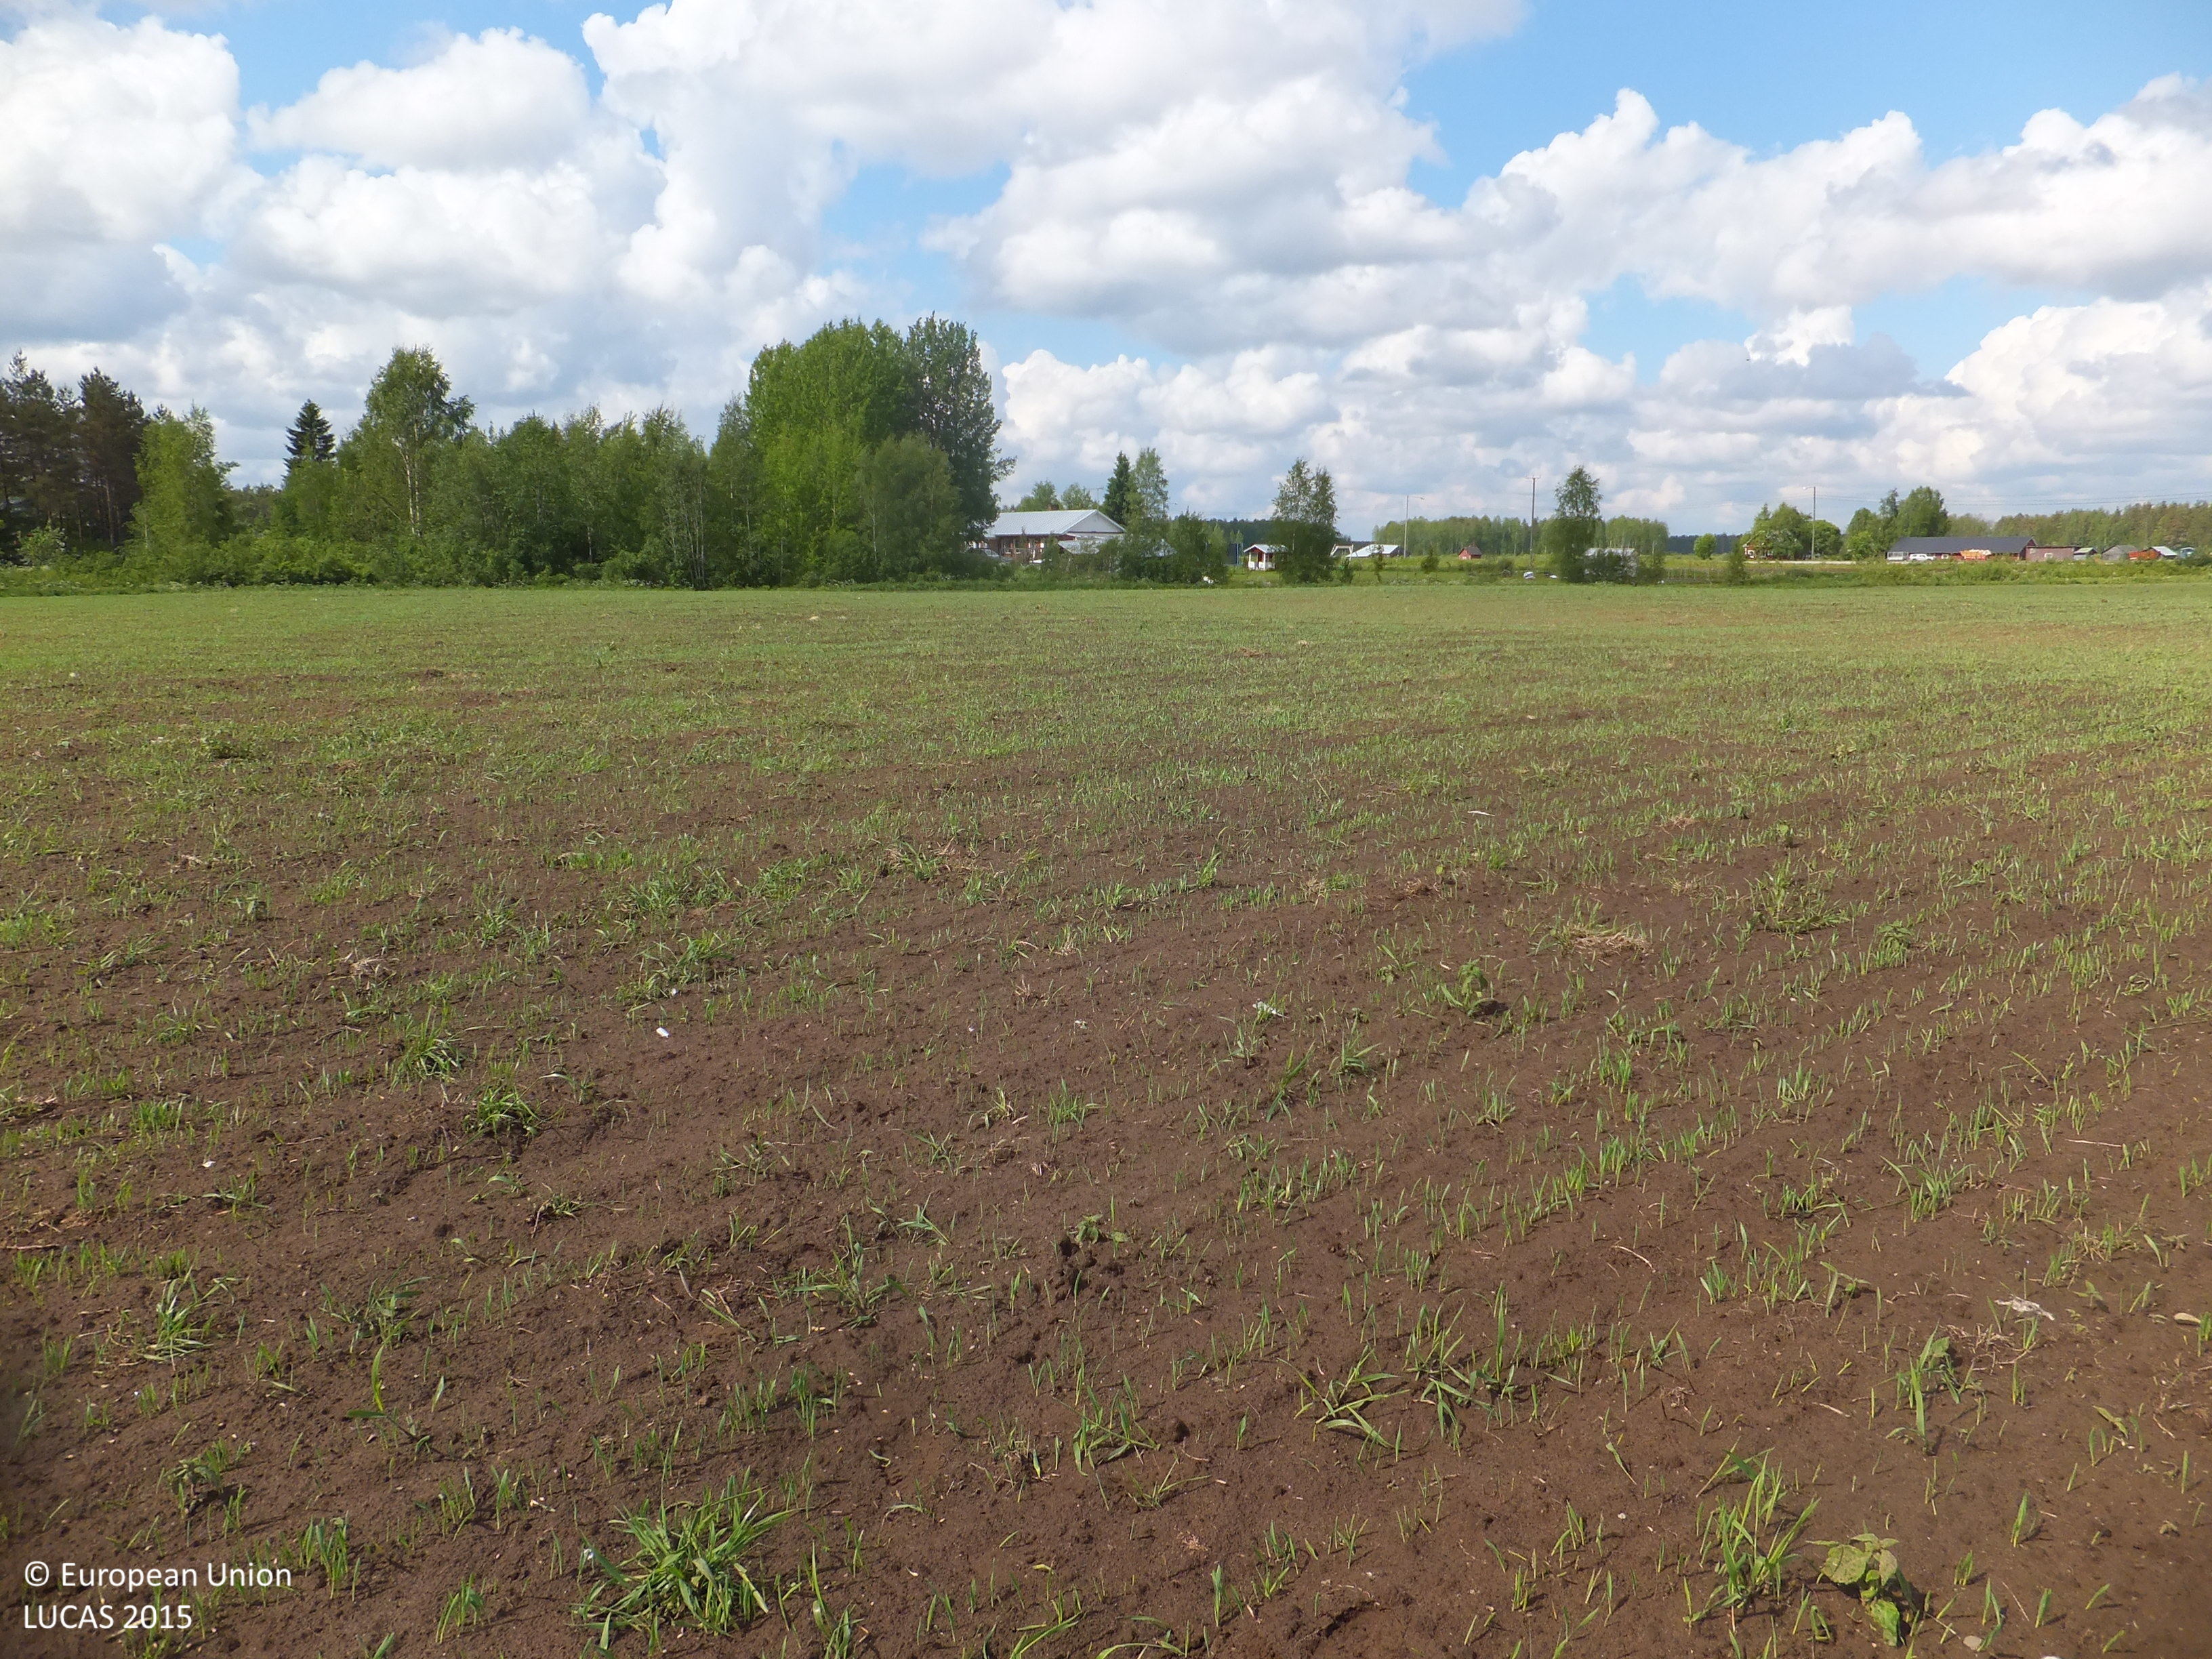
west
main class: Cropland
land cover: Barley
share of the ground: < 10 %
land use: Agriculture (excluding fallow land and kitchen gardens)
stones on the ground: < 10 %
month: June
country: FI
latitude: 63.6006
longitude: 24.0813
